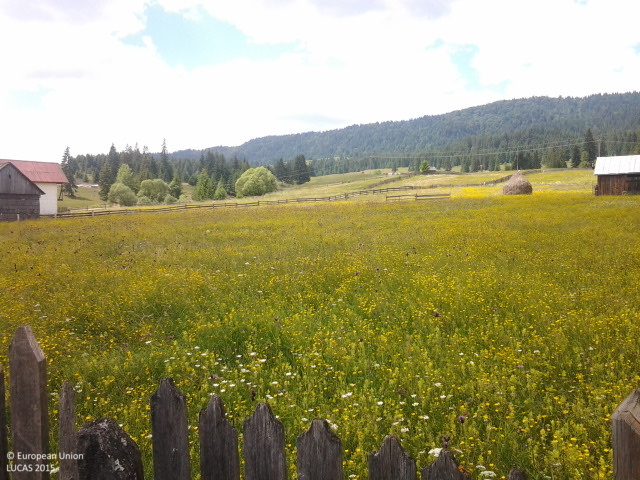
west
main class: Grassland
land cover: Grassland without tree/shrub cover
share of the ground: > 75 %
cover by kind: herbaceous plants 100 %
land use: Agriculture (excluding fallow land and kitchen gardens)
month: June
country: RO
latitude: 46.9926
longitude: 25.4837
